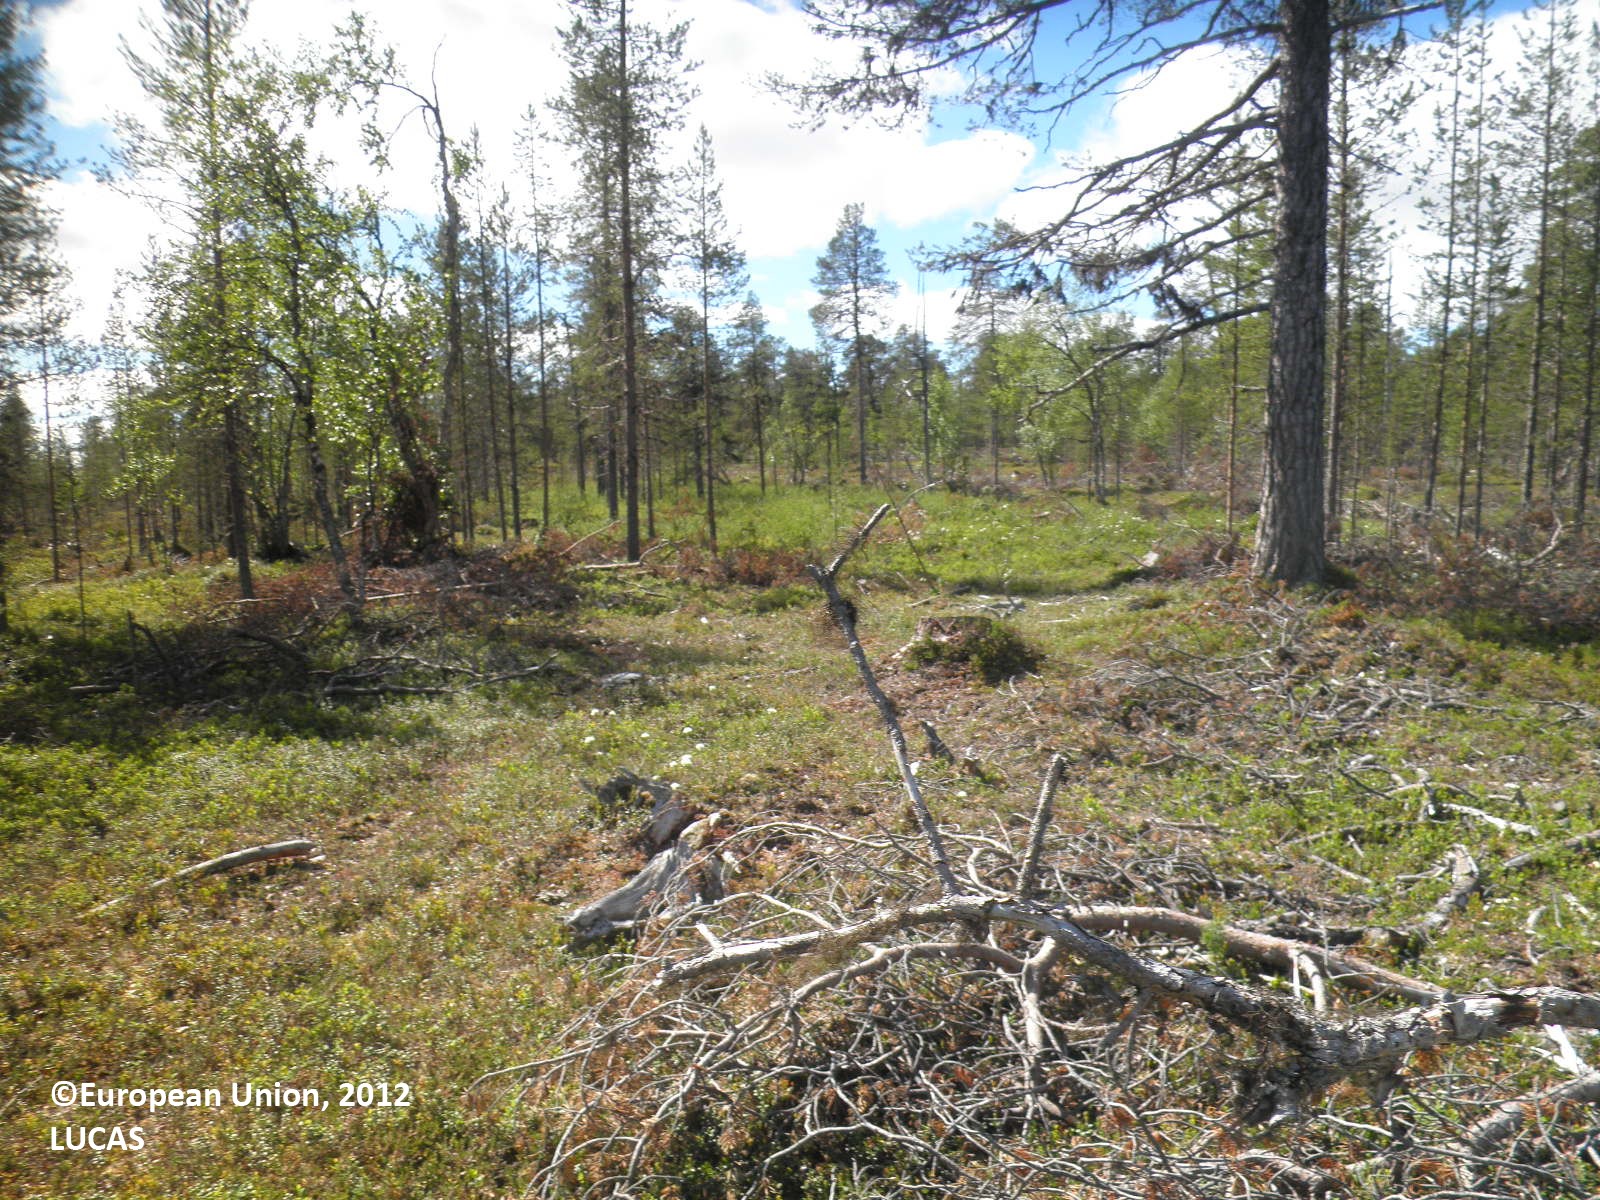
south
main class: Shrubland
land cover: Shrubland with sparse tree cover
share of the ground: > 75 %
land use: Forestry
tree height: > 5 m
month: July
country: FI
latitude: 68.6785
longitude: 26.2870
